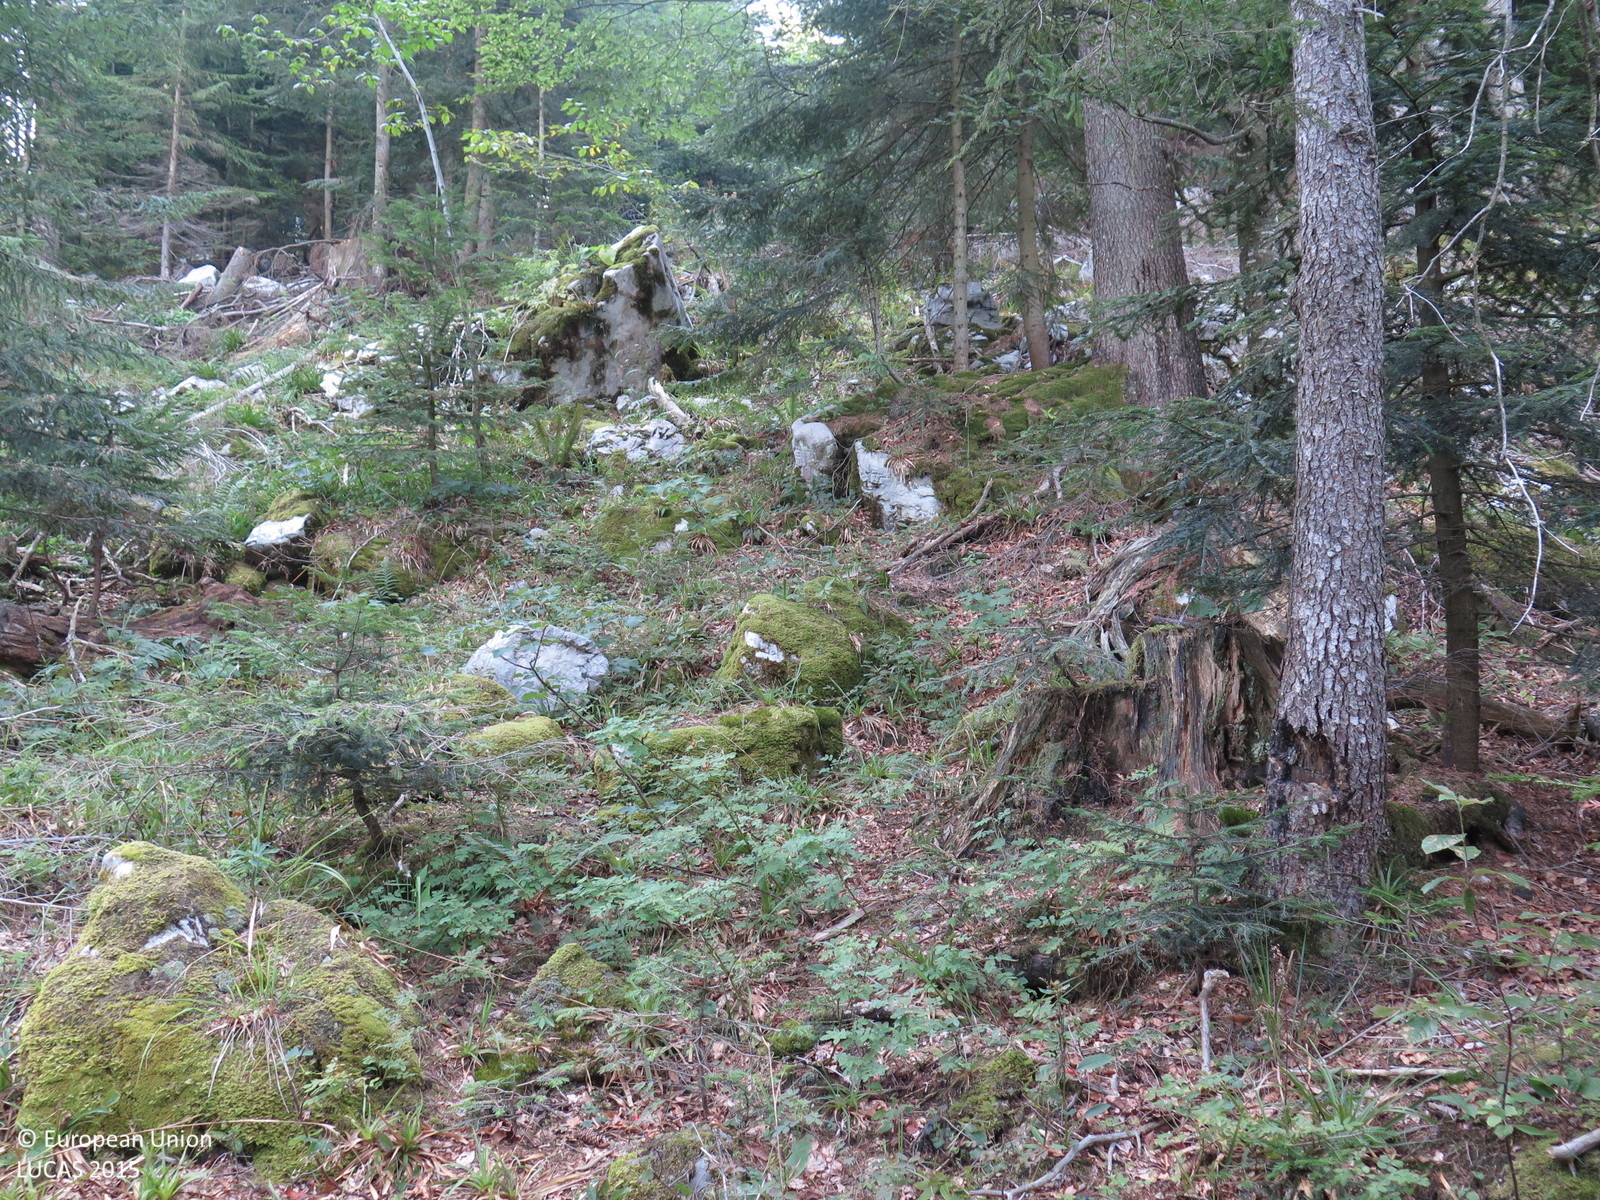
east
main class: Woodland
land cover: Other mixed woodland
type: mountainous beech forest
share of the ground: > 75 %
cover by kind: coniferous forest trees 75 %, broadleaved forest trees 25 %
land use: Forestry
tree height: > 5 m
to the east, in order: Other mixed woodland; Tracks; Other mixed woodland
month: August
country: HR
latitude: 45.3325
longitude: 14.9843
